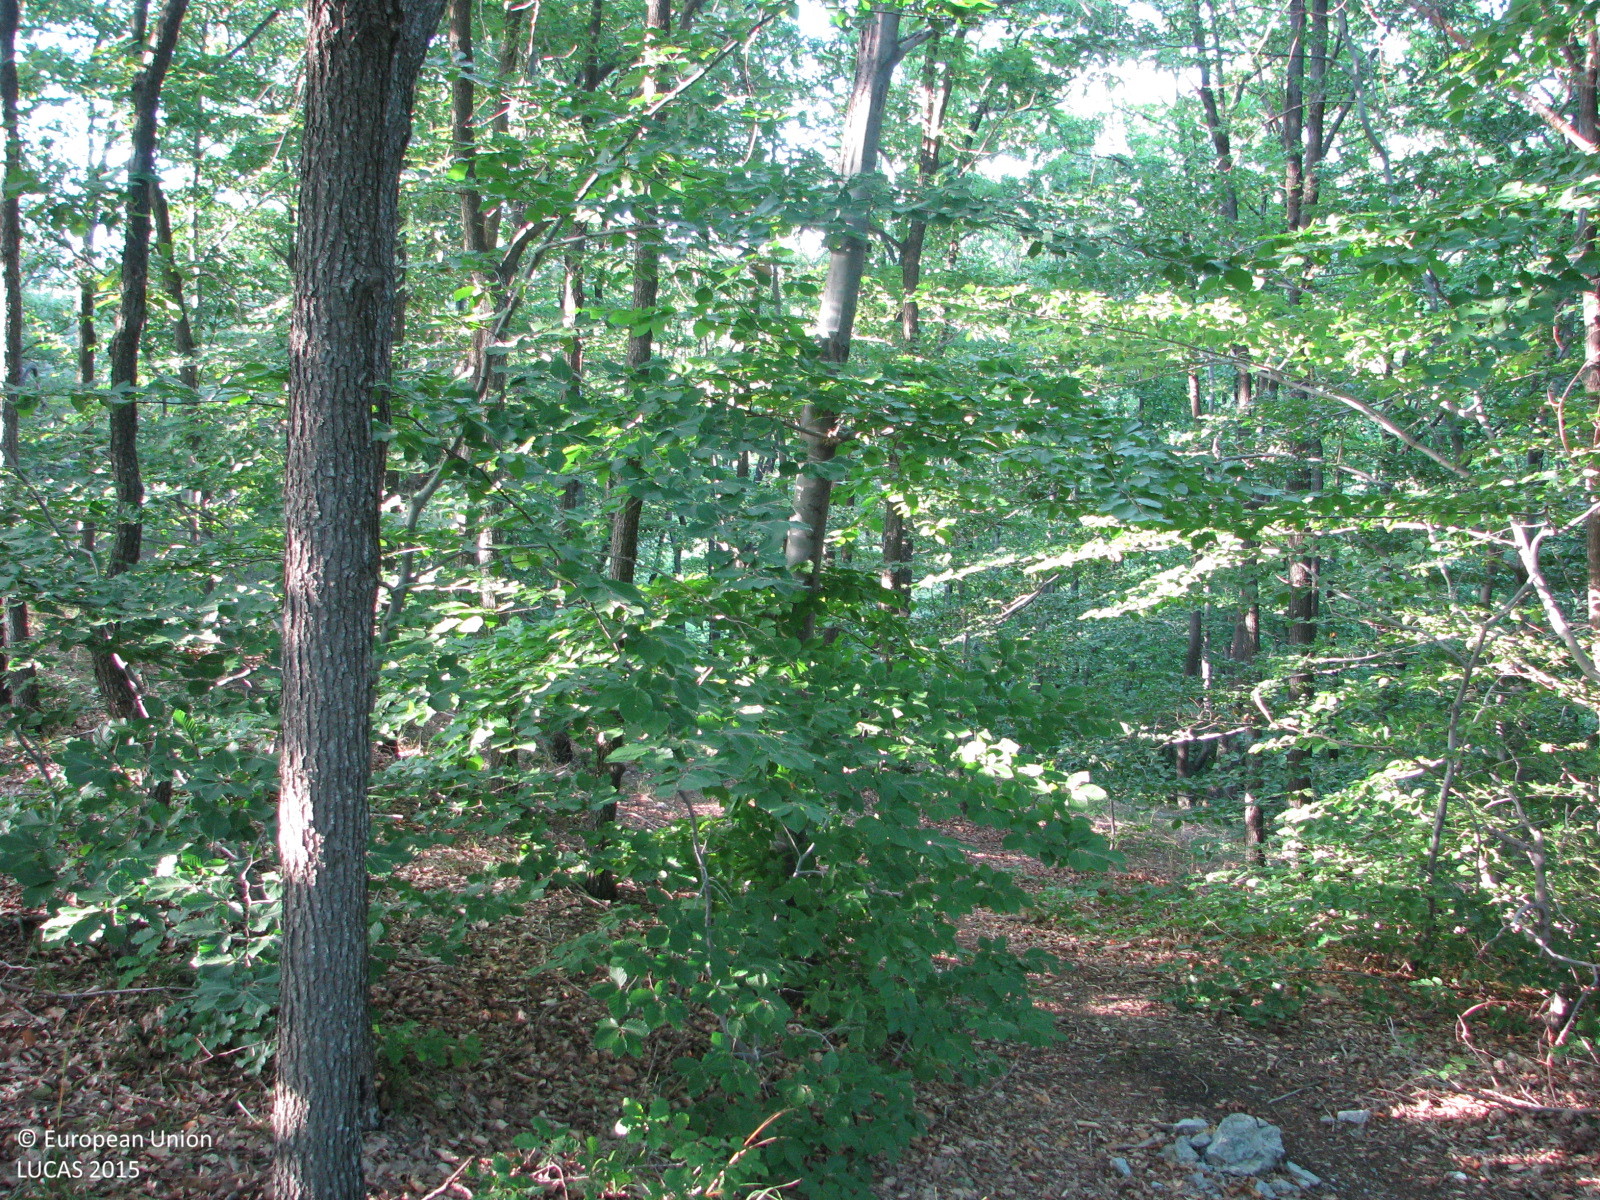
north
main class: Woodland
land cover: Broadleaved woodland
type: beech forest
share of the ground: 50 - 75 %
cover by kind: broadleaved forest trees 70 %, unconsolidated bare surface 20 %, shrubs 5 %, herbaceous plants 5 %
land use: Forestry
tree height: > 5 m
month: August
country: BG
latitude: 42.7212
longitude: 26.2952
